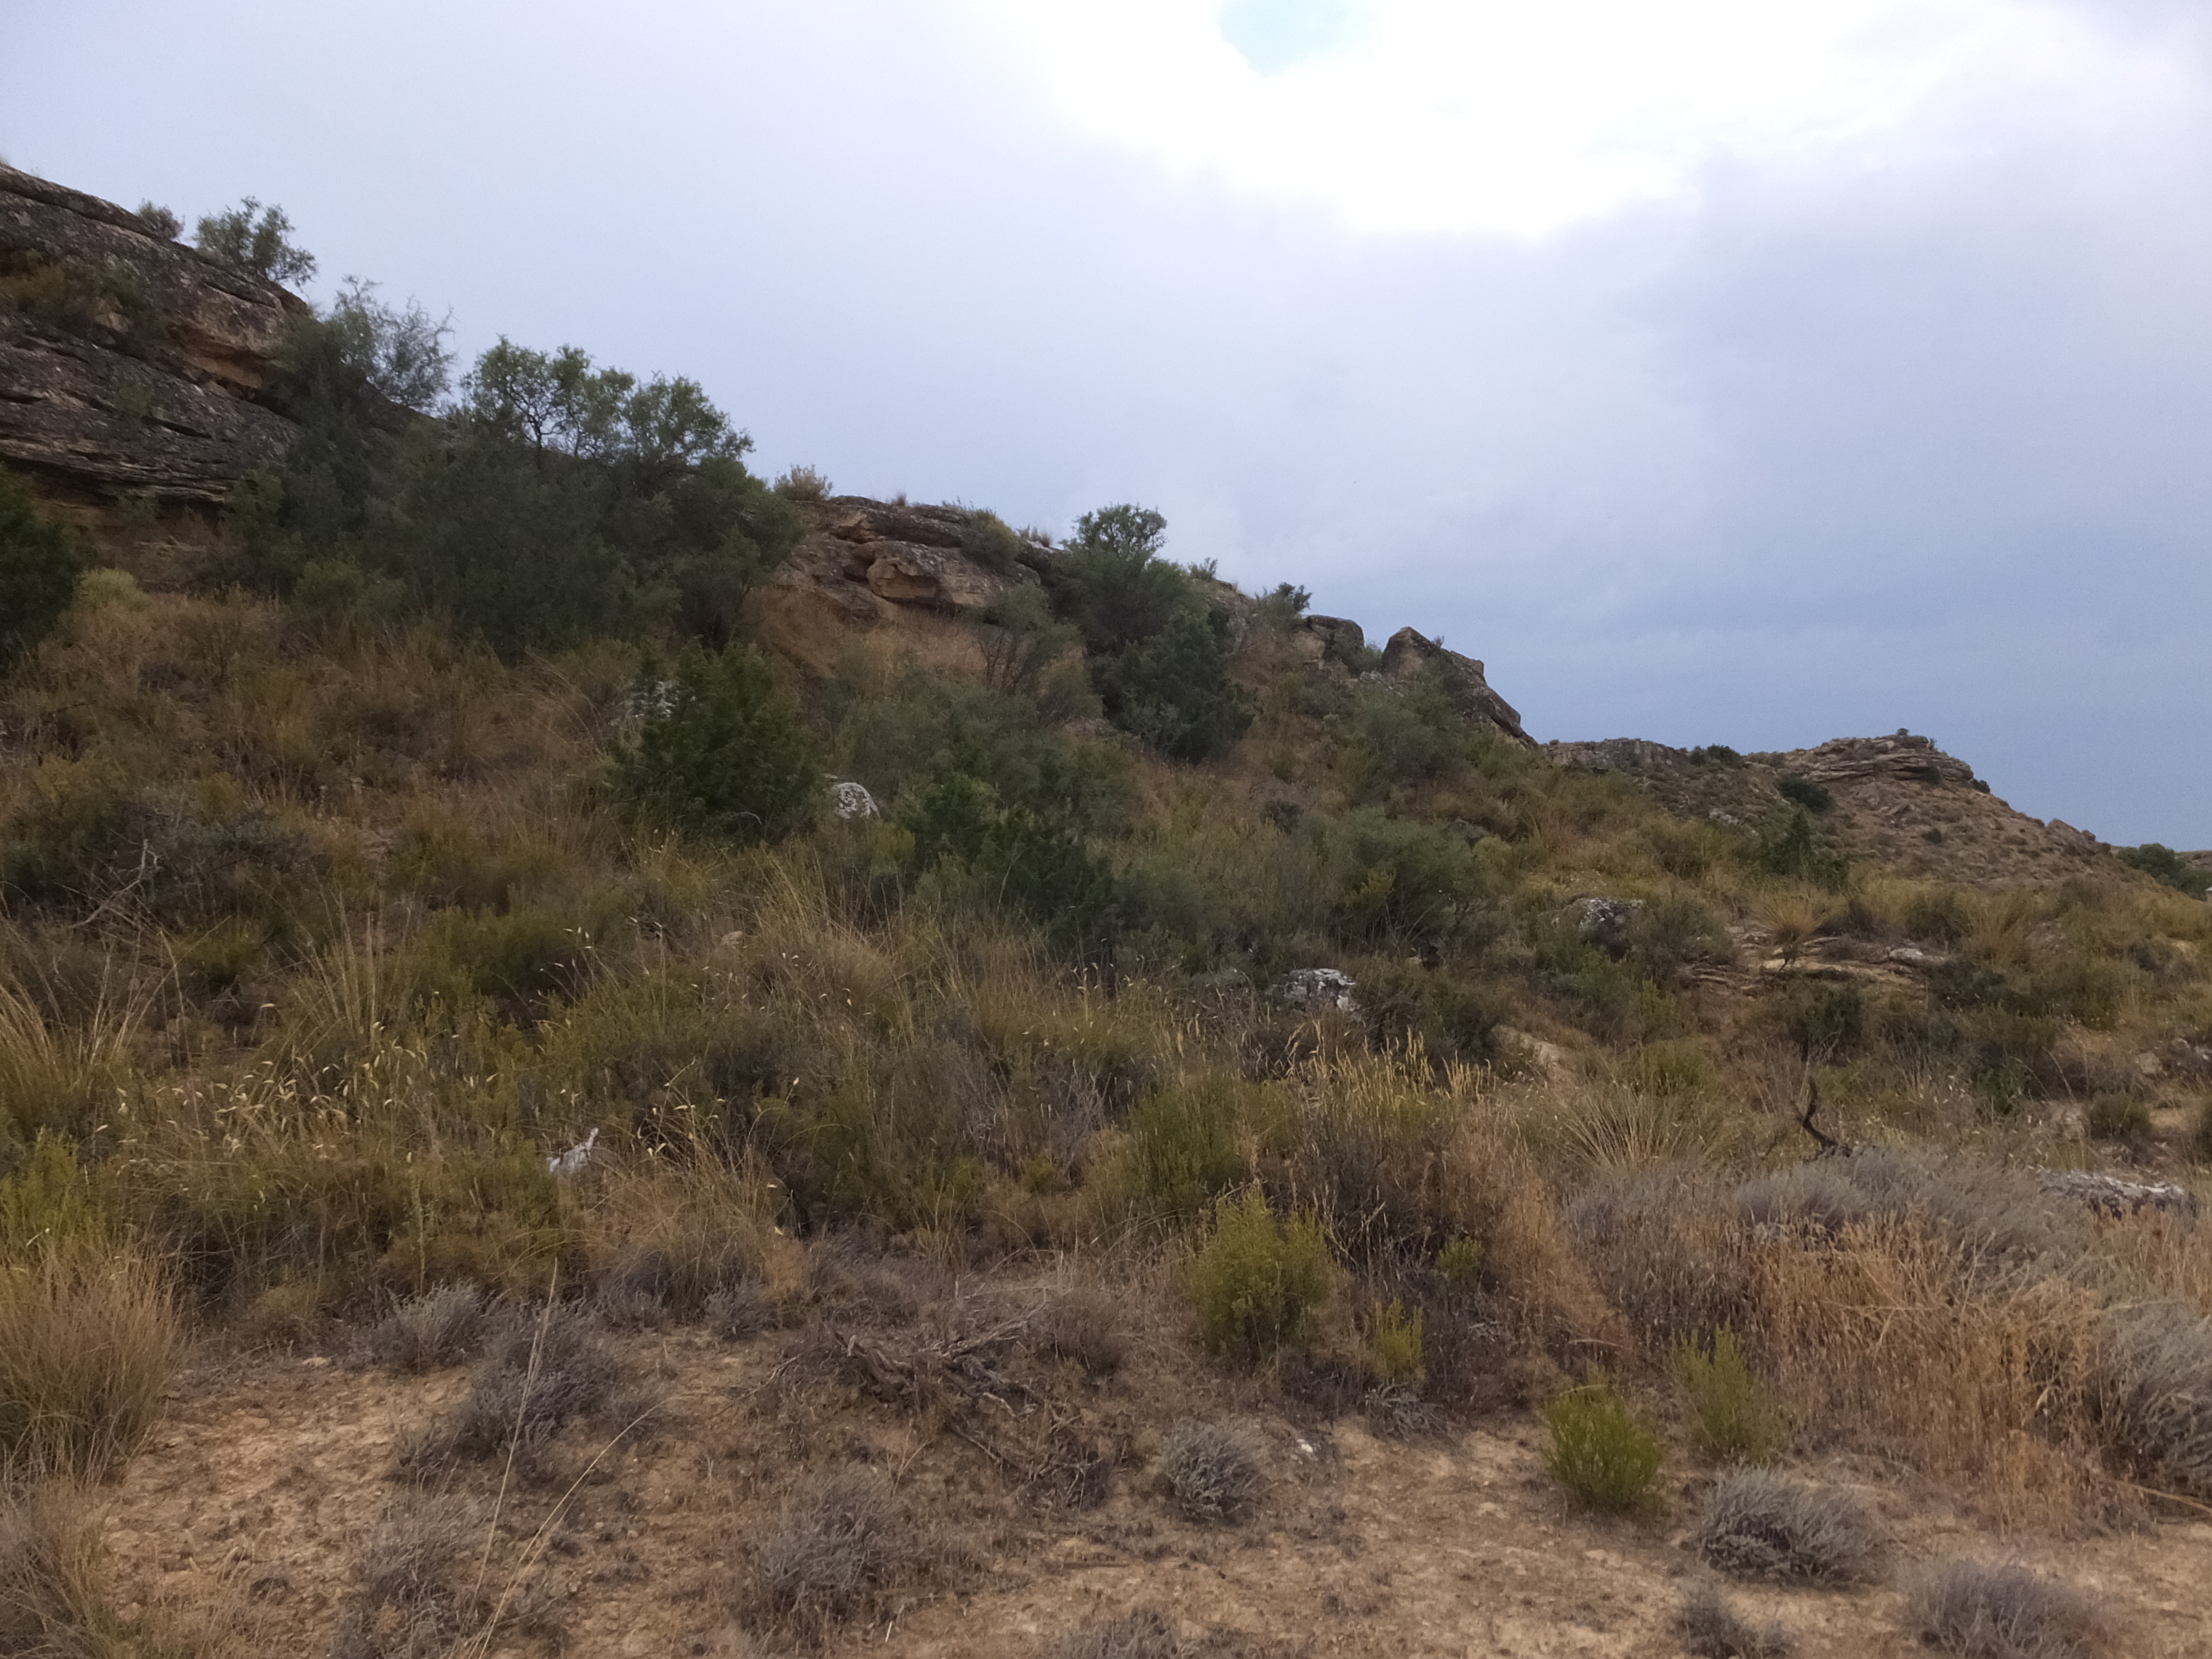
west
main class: Grassland
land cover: Grassland without tree/shrub cover
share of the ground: > 75 %
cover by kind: herbaceous plants 95 %, shrubs 5 %
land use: Semi-natural and natural areas not in use
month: July
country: ES
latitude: 41.2232
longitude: -0.0686
